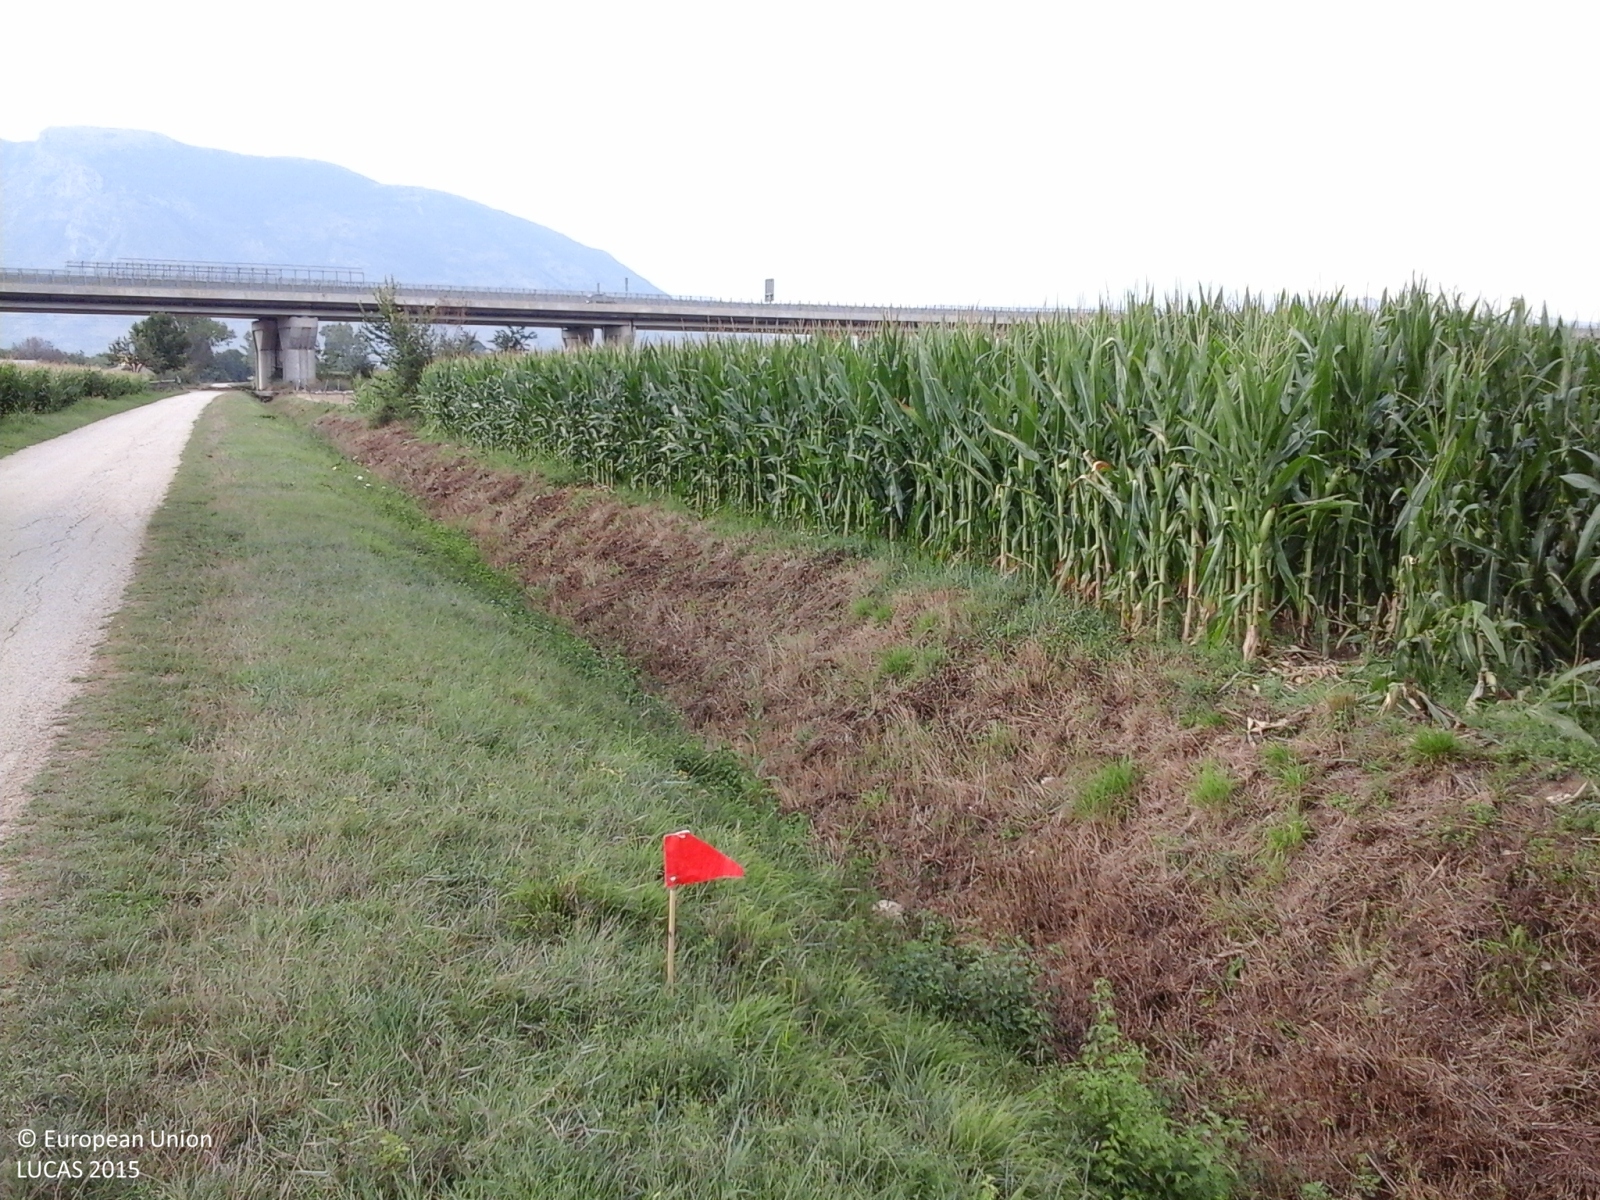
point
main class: Cropland
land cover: Maize
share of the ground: > 75 %
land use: Agriculture (excluding fallow land and kitchen gardens)
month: August
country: IT
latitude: 41.4508
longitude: 14.0667
